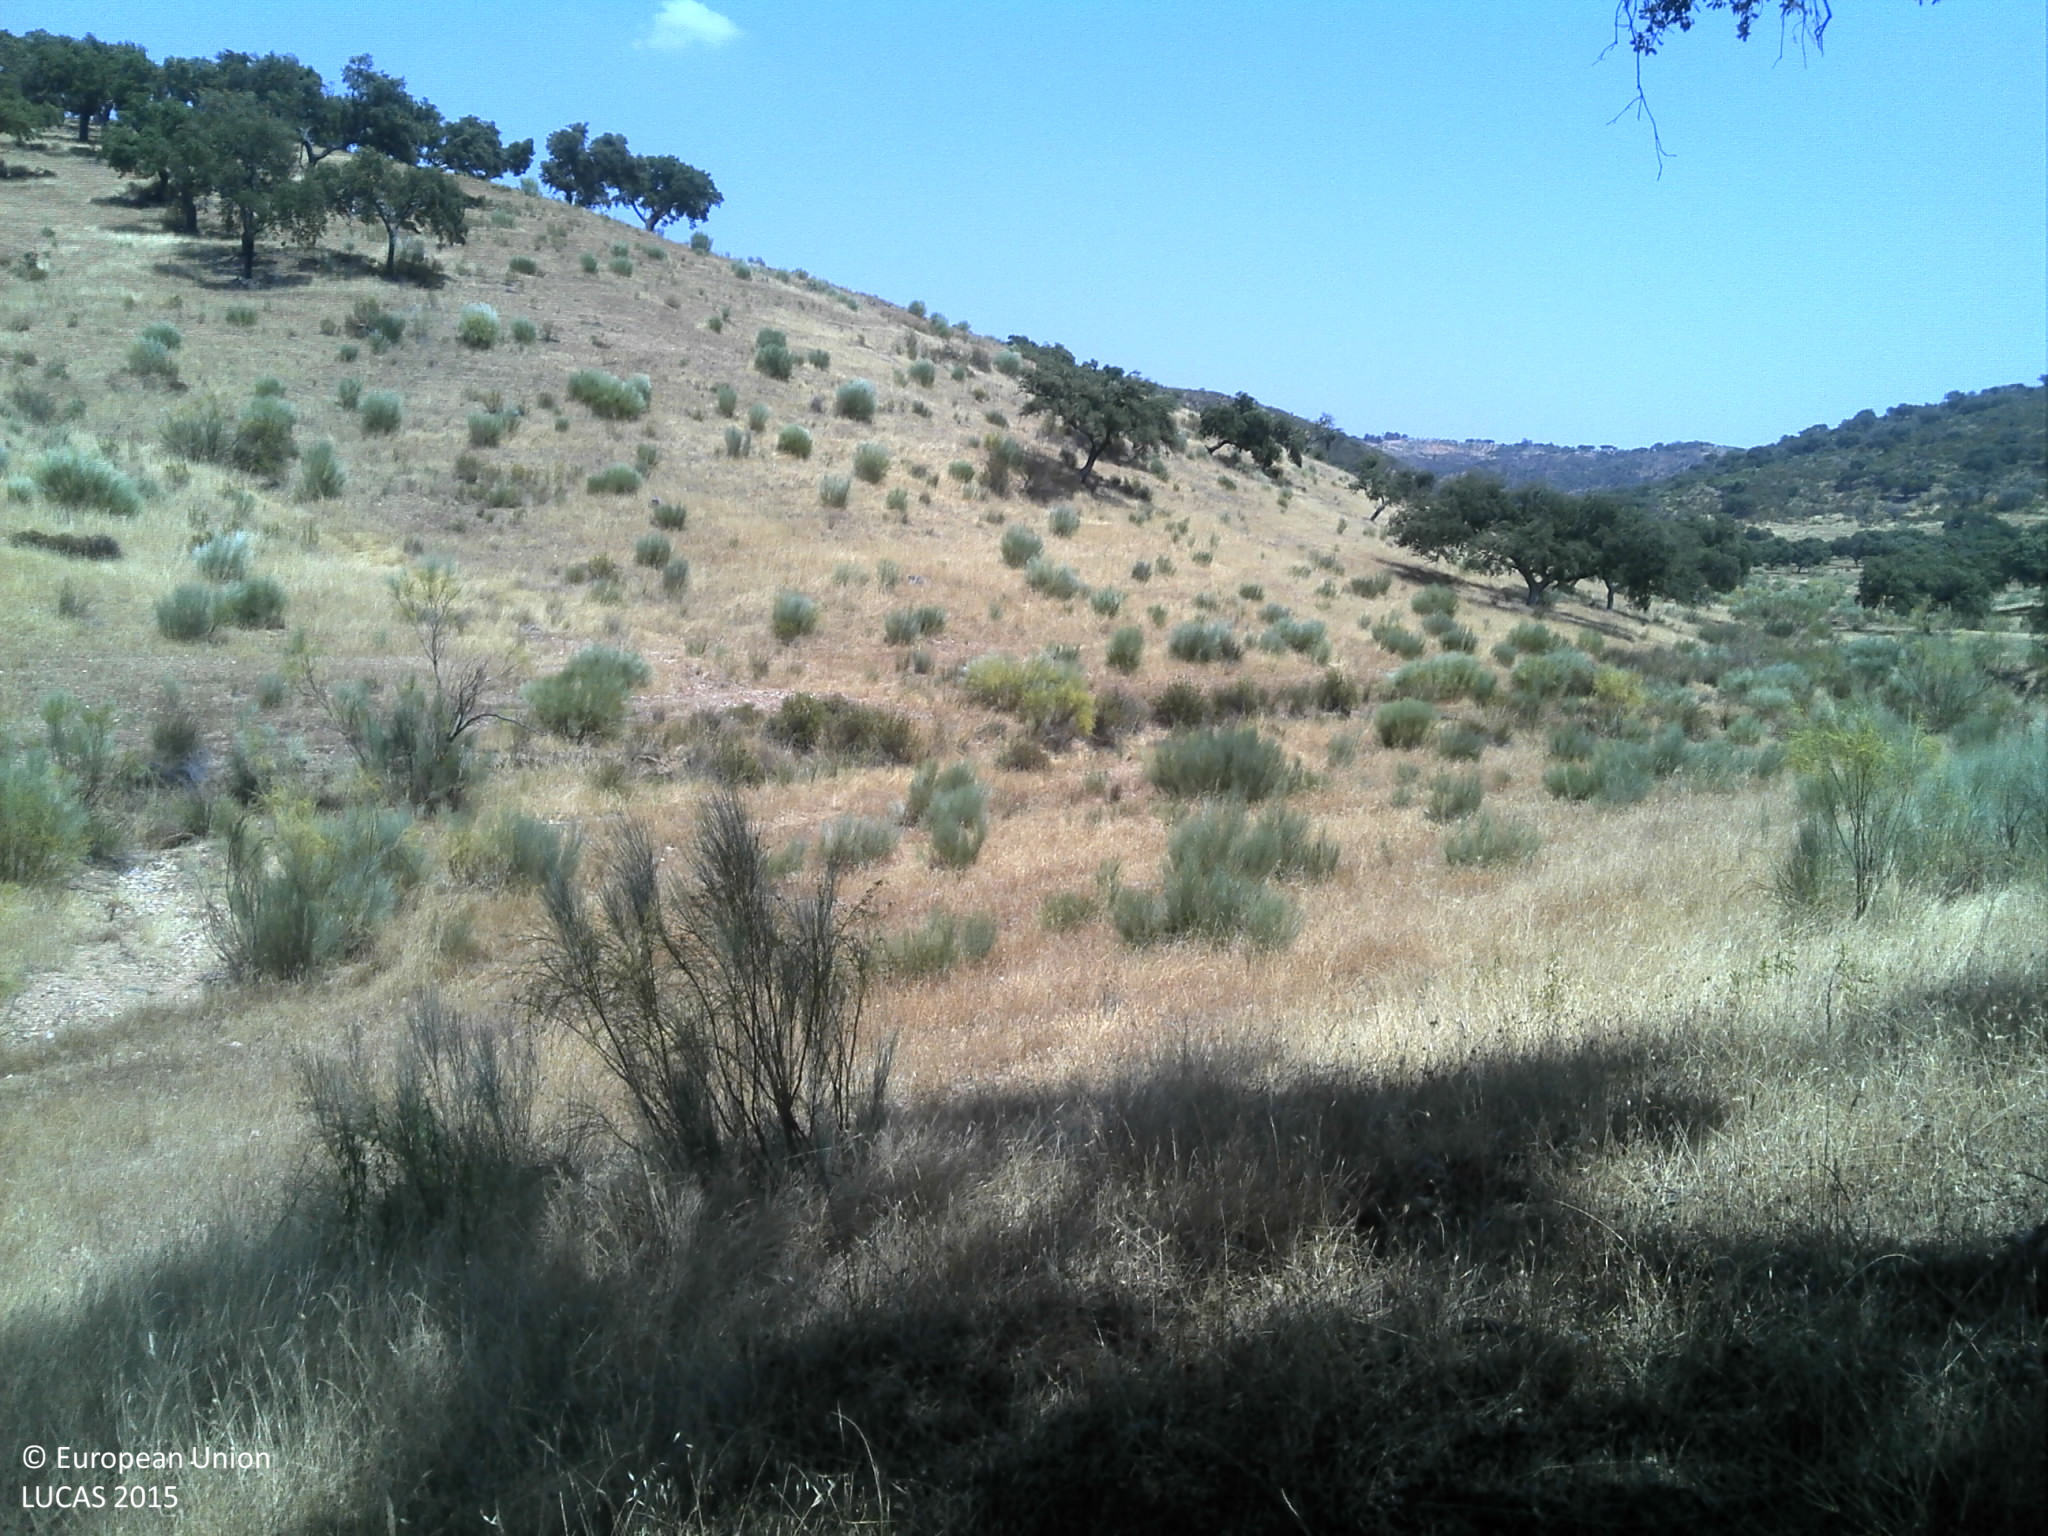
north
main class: Woodland
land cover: Broadleaved woodland
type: broadleaved evergreen forest
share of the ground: 25 - 50 %
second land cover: Grassland without tree/shrub cover
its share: 50 - 75 %
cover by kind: herbaceous plants 60 %, broadleaved forest trees 30 %, shrubs 5 %, unconsolidated bare surface 5 %
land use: Forestry
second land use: Agriculture (excluding fallow land and kitchen gardens)
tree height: > 5 m
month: June
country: PT
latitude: 39.7439
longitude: -7.2344
